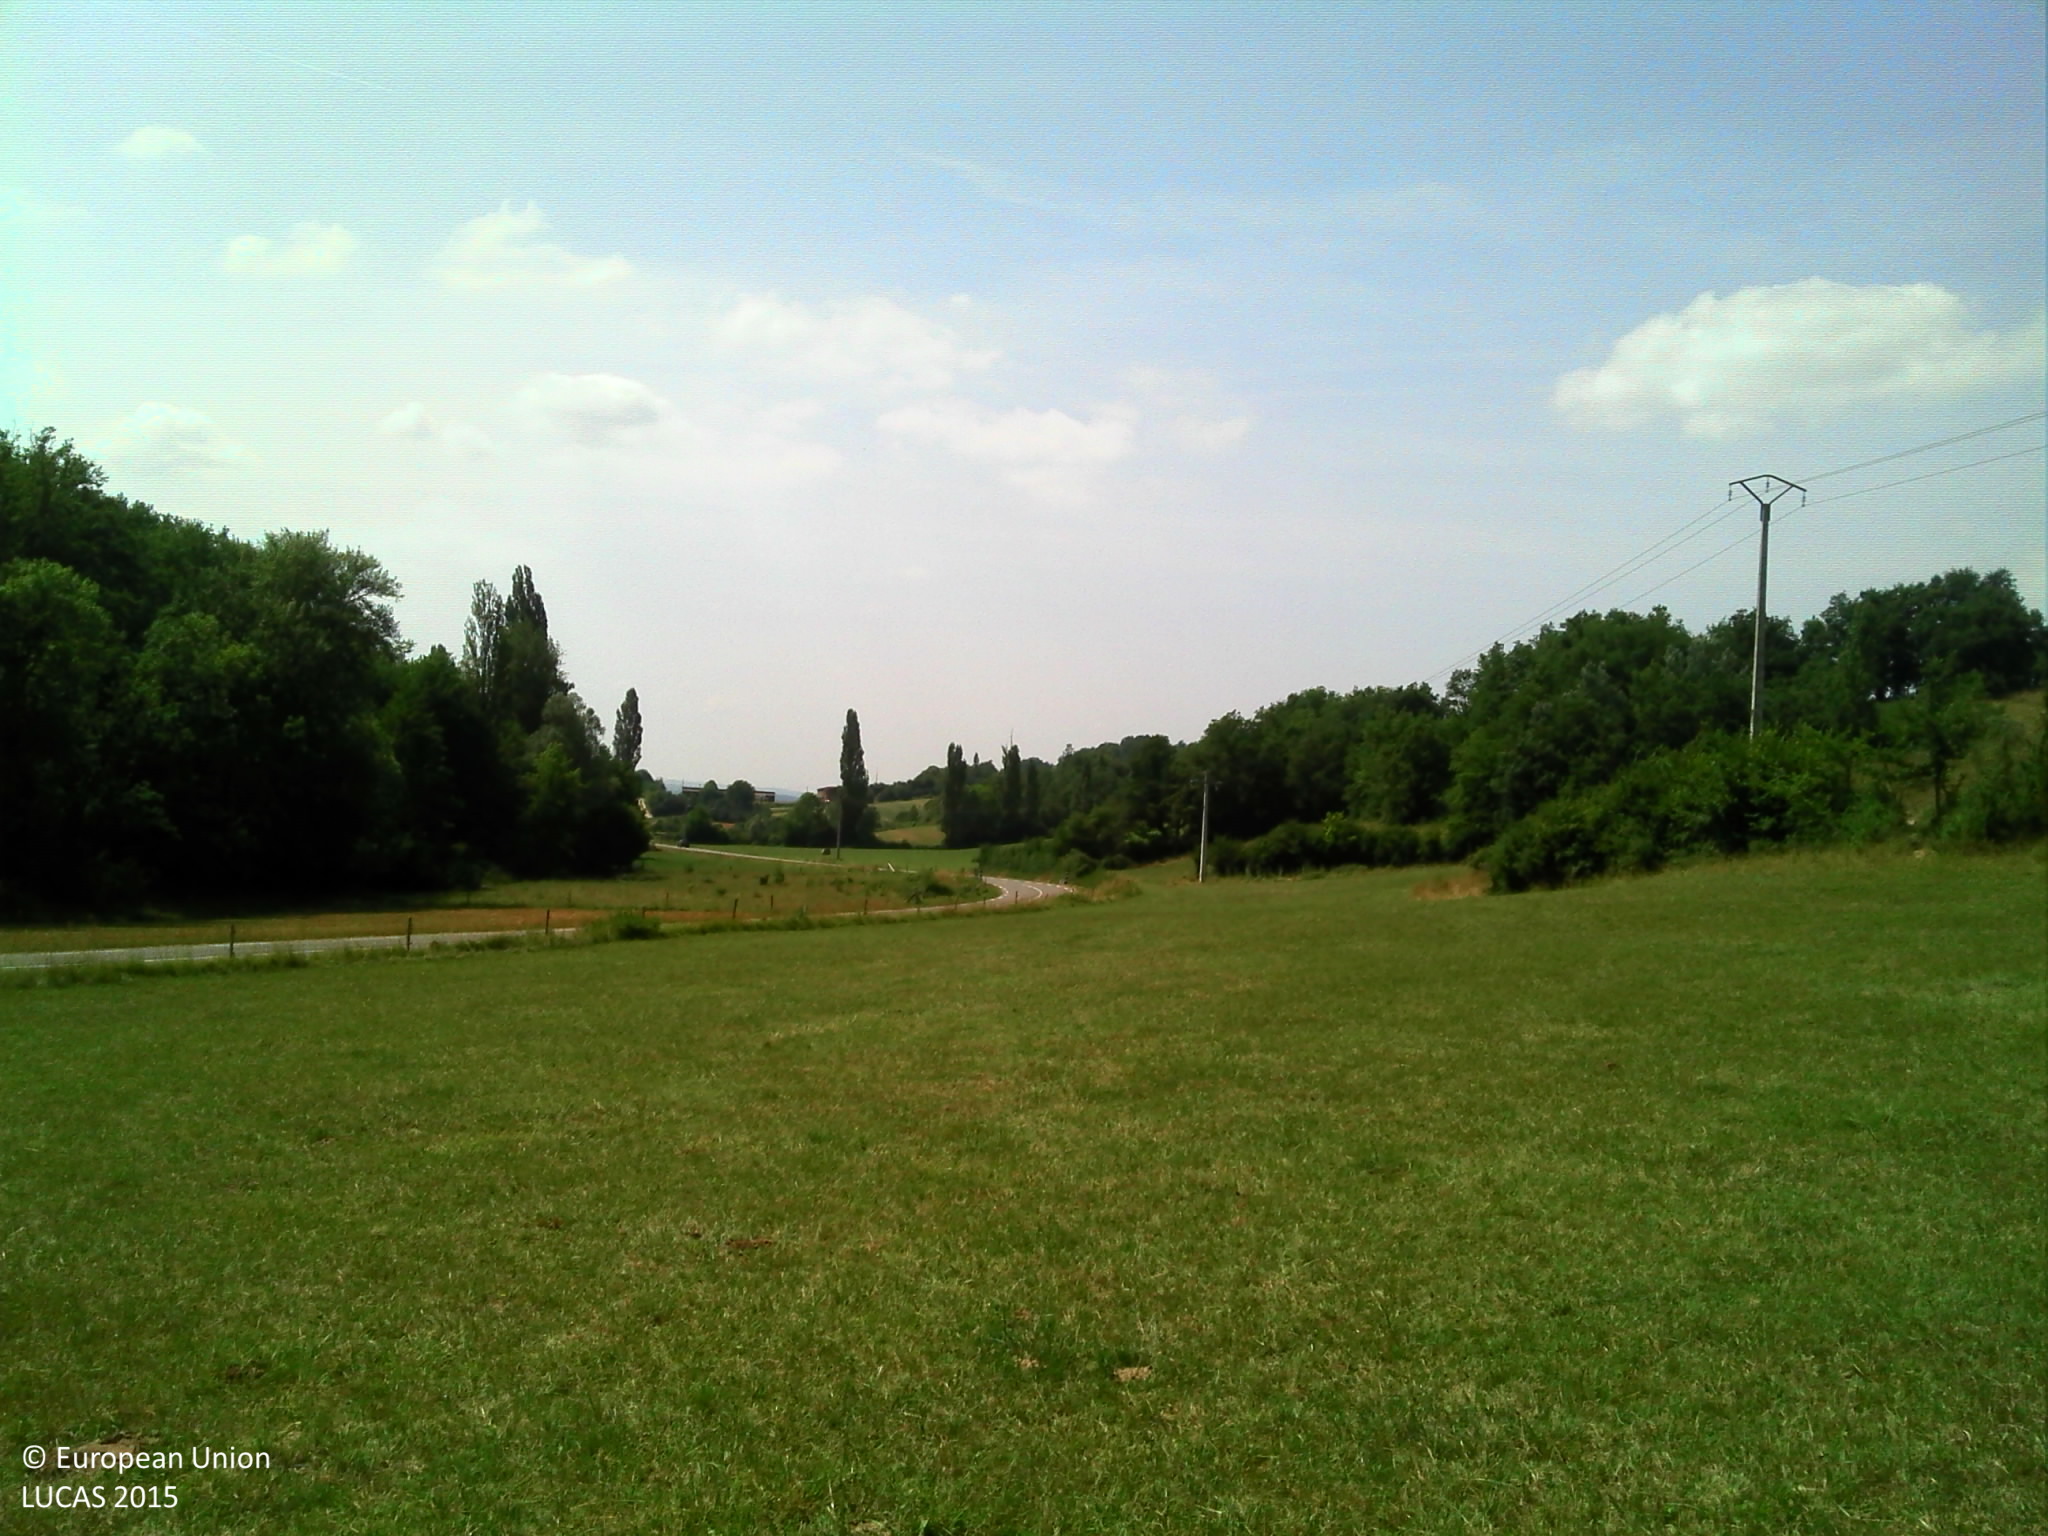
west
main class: Grassland
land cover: Grassland without tree/shrub cover
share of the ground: > 75 %
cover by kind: herbaceous plants 100 %
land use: Agriculture (excluding fallow land and kitchen gardens)
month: July
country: FR
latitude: 43.0878
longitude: 1.4187
